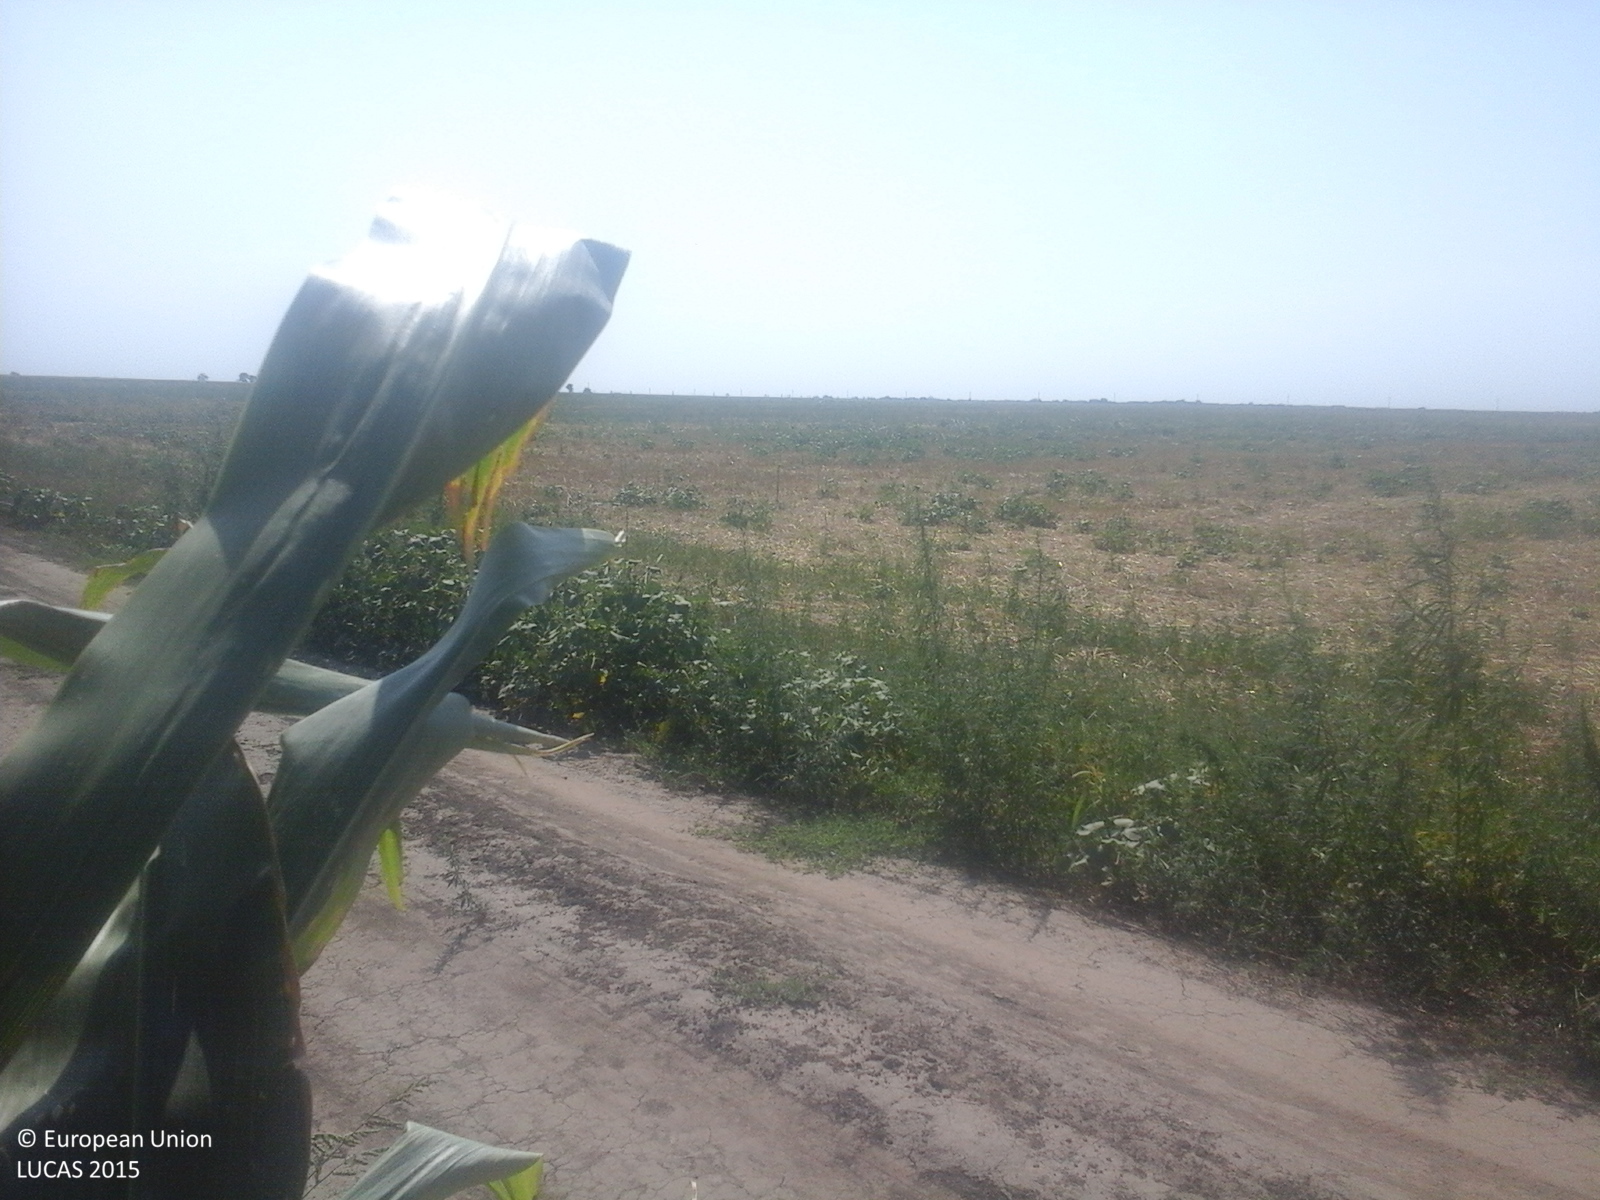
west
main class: Cropland
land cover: Maize
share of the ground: > 75 %
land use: Agriculture (excluding fallow land and kitchen gardens)
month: August
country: RO
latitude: 45.2196
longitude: 27.5344
